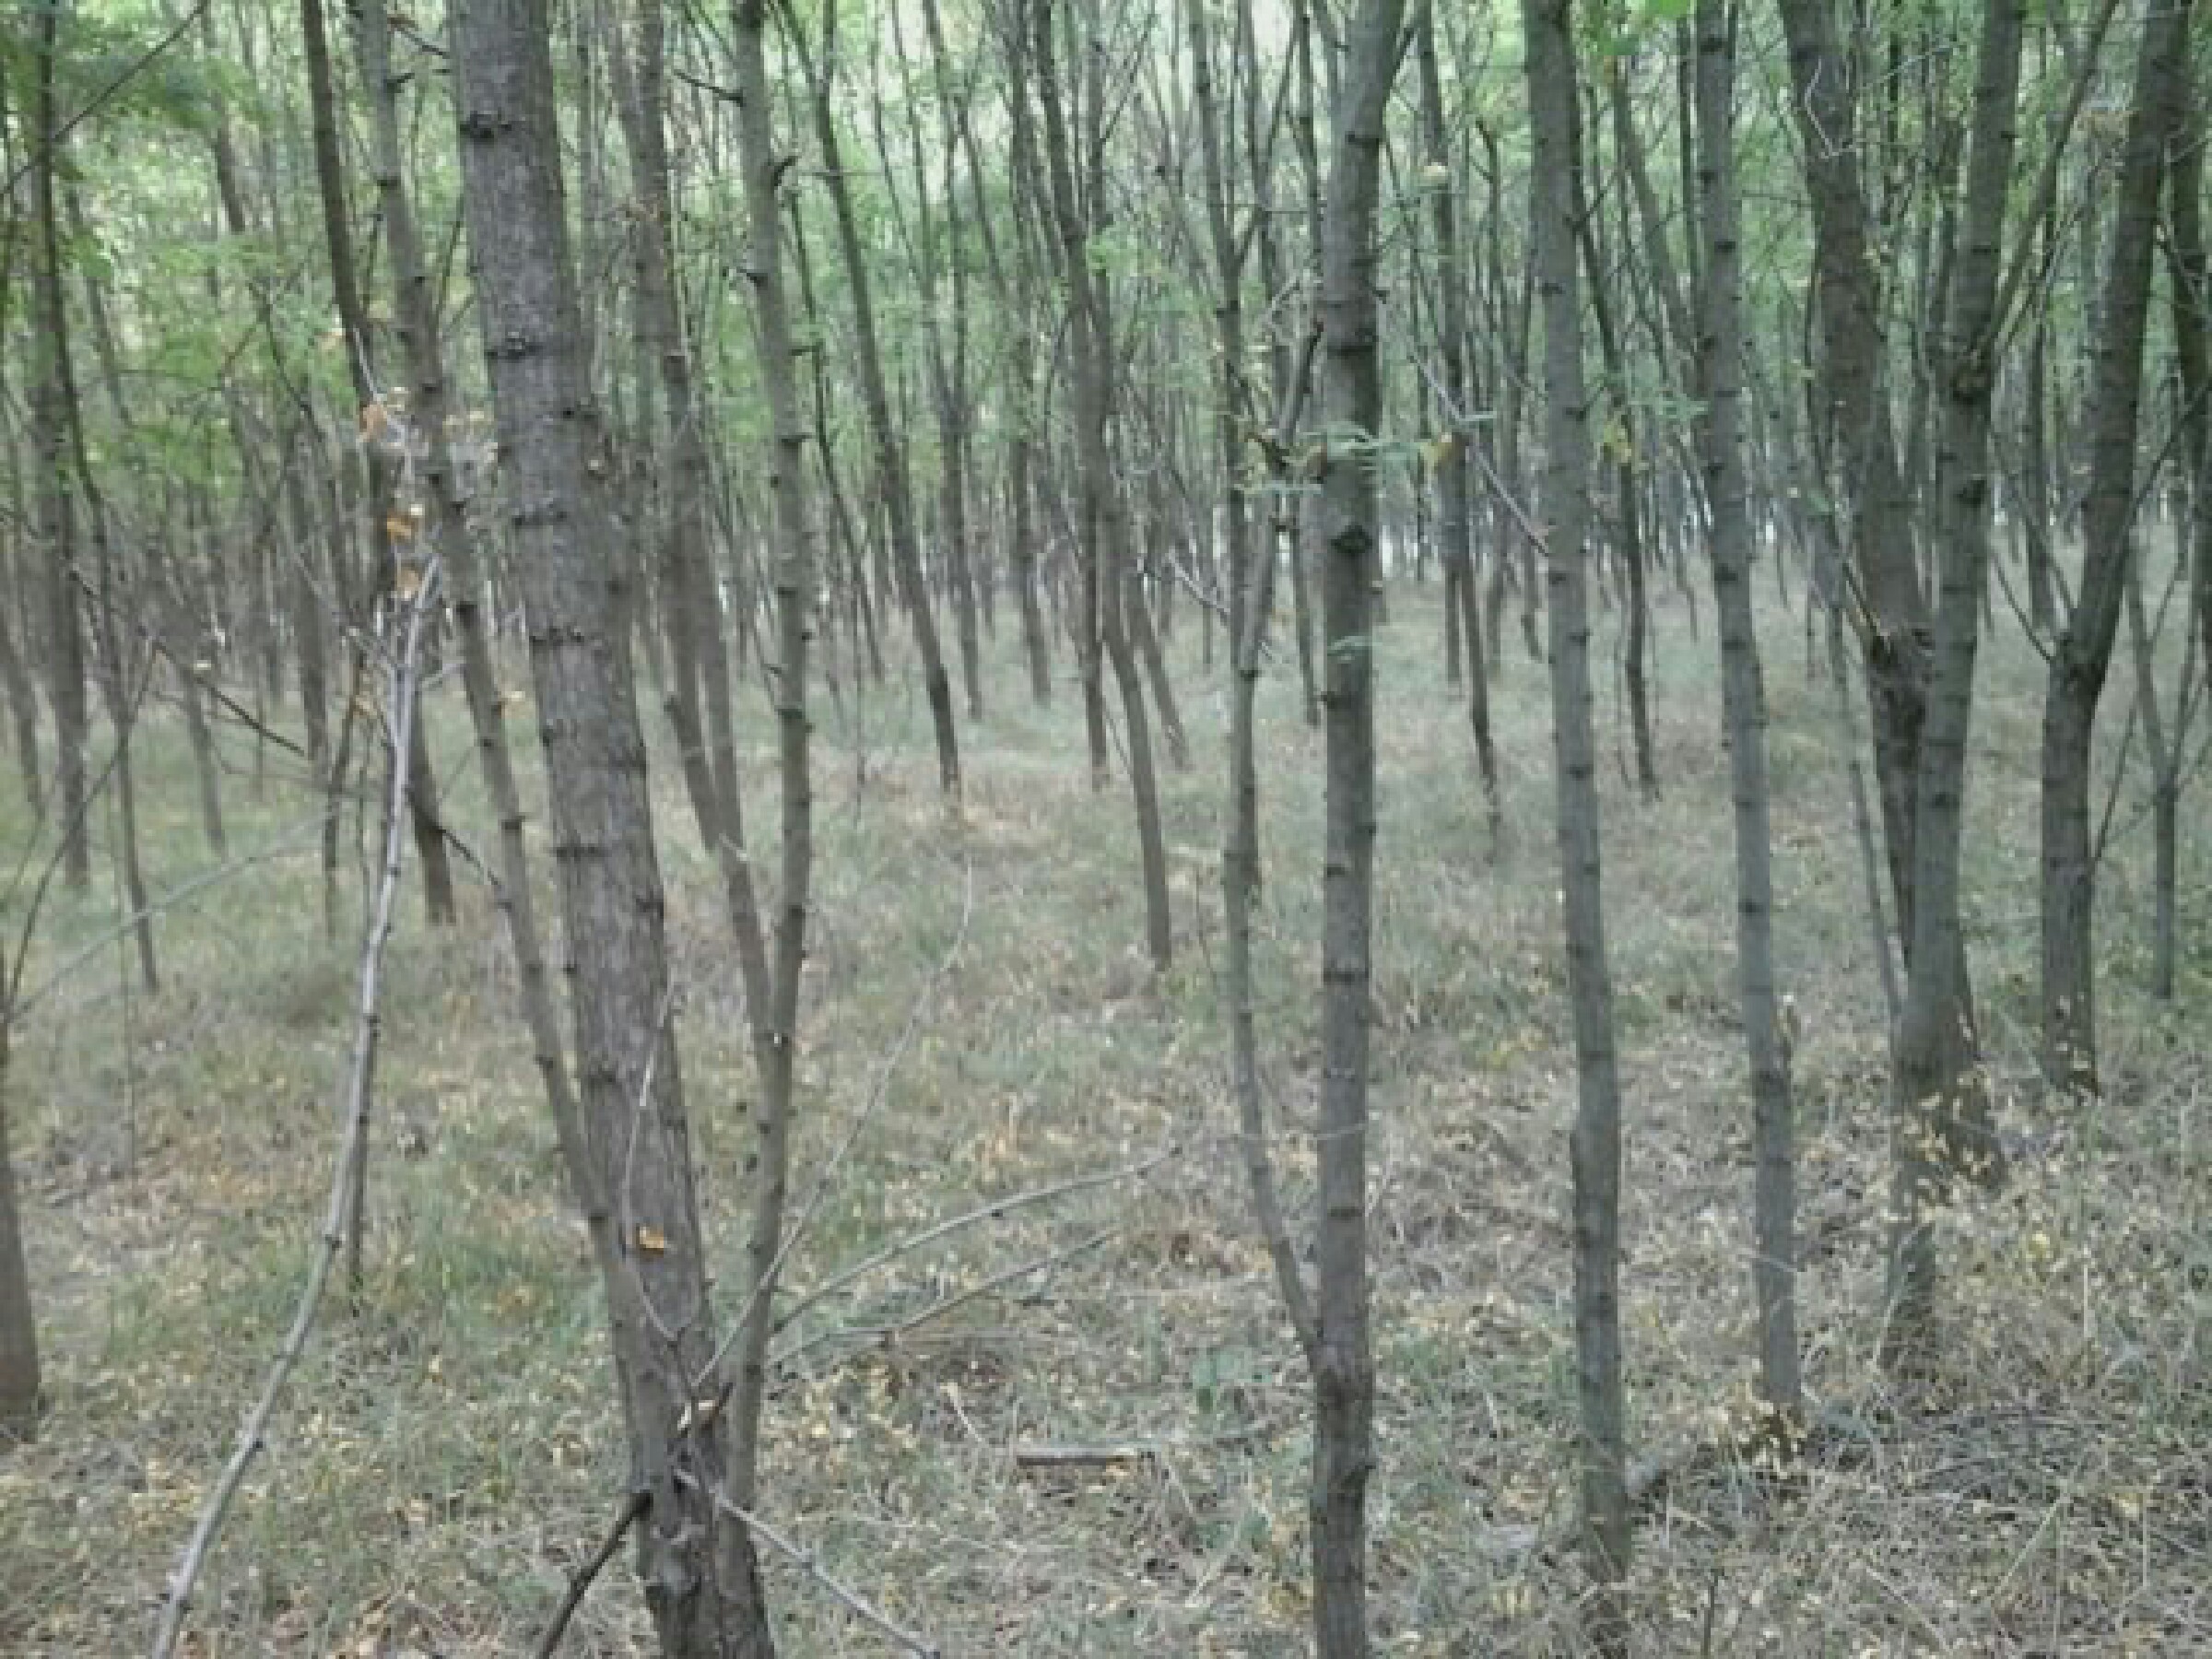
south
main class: Woodland
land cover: Broadleaved woodland
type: exotic forest
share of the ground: > 75 %
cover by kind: broadleaved forest trees 100 %
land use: Forestry
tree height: > 5 m
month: July
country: HU
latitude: 47.8448
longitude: 19.3351
